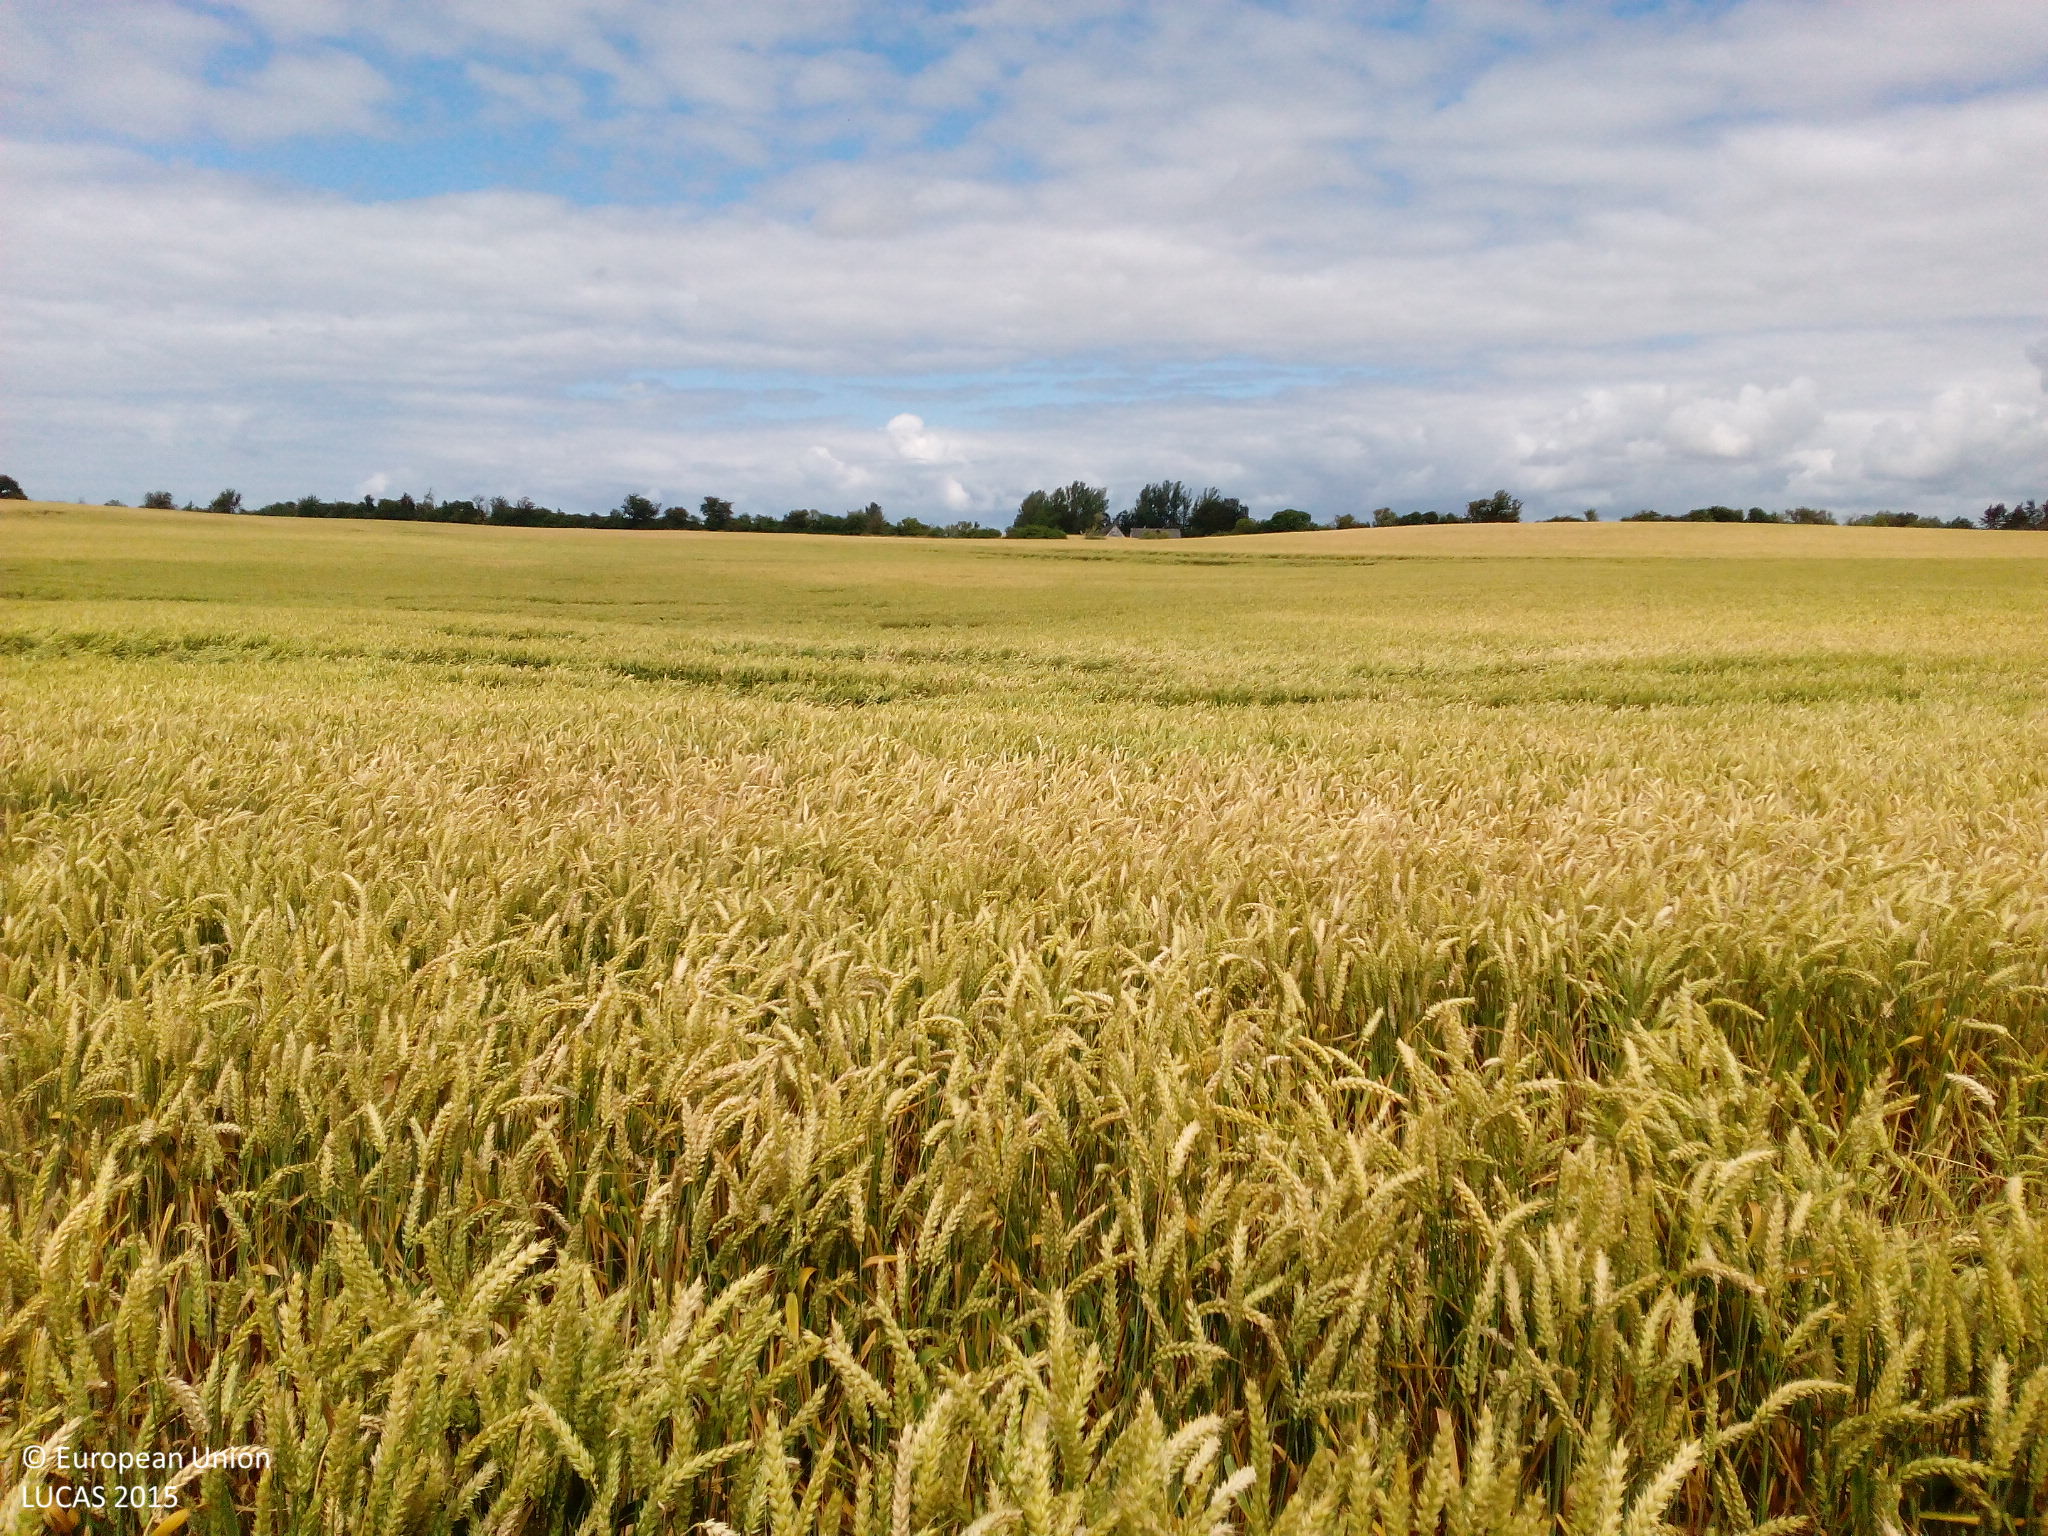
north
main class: Cropland
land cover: Common wheat
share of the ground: > 75 %
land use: Agriculture (excluding fallow land and kitchen gardens)
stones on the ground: < 10 %
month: July
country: DK
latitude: 55.9897
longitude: 12.1620
